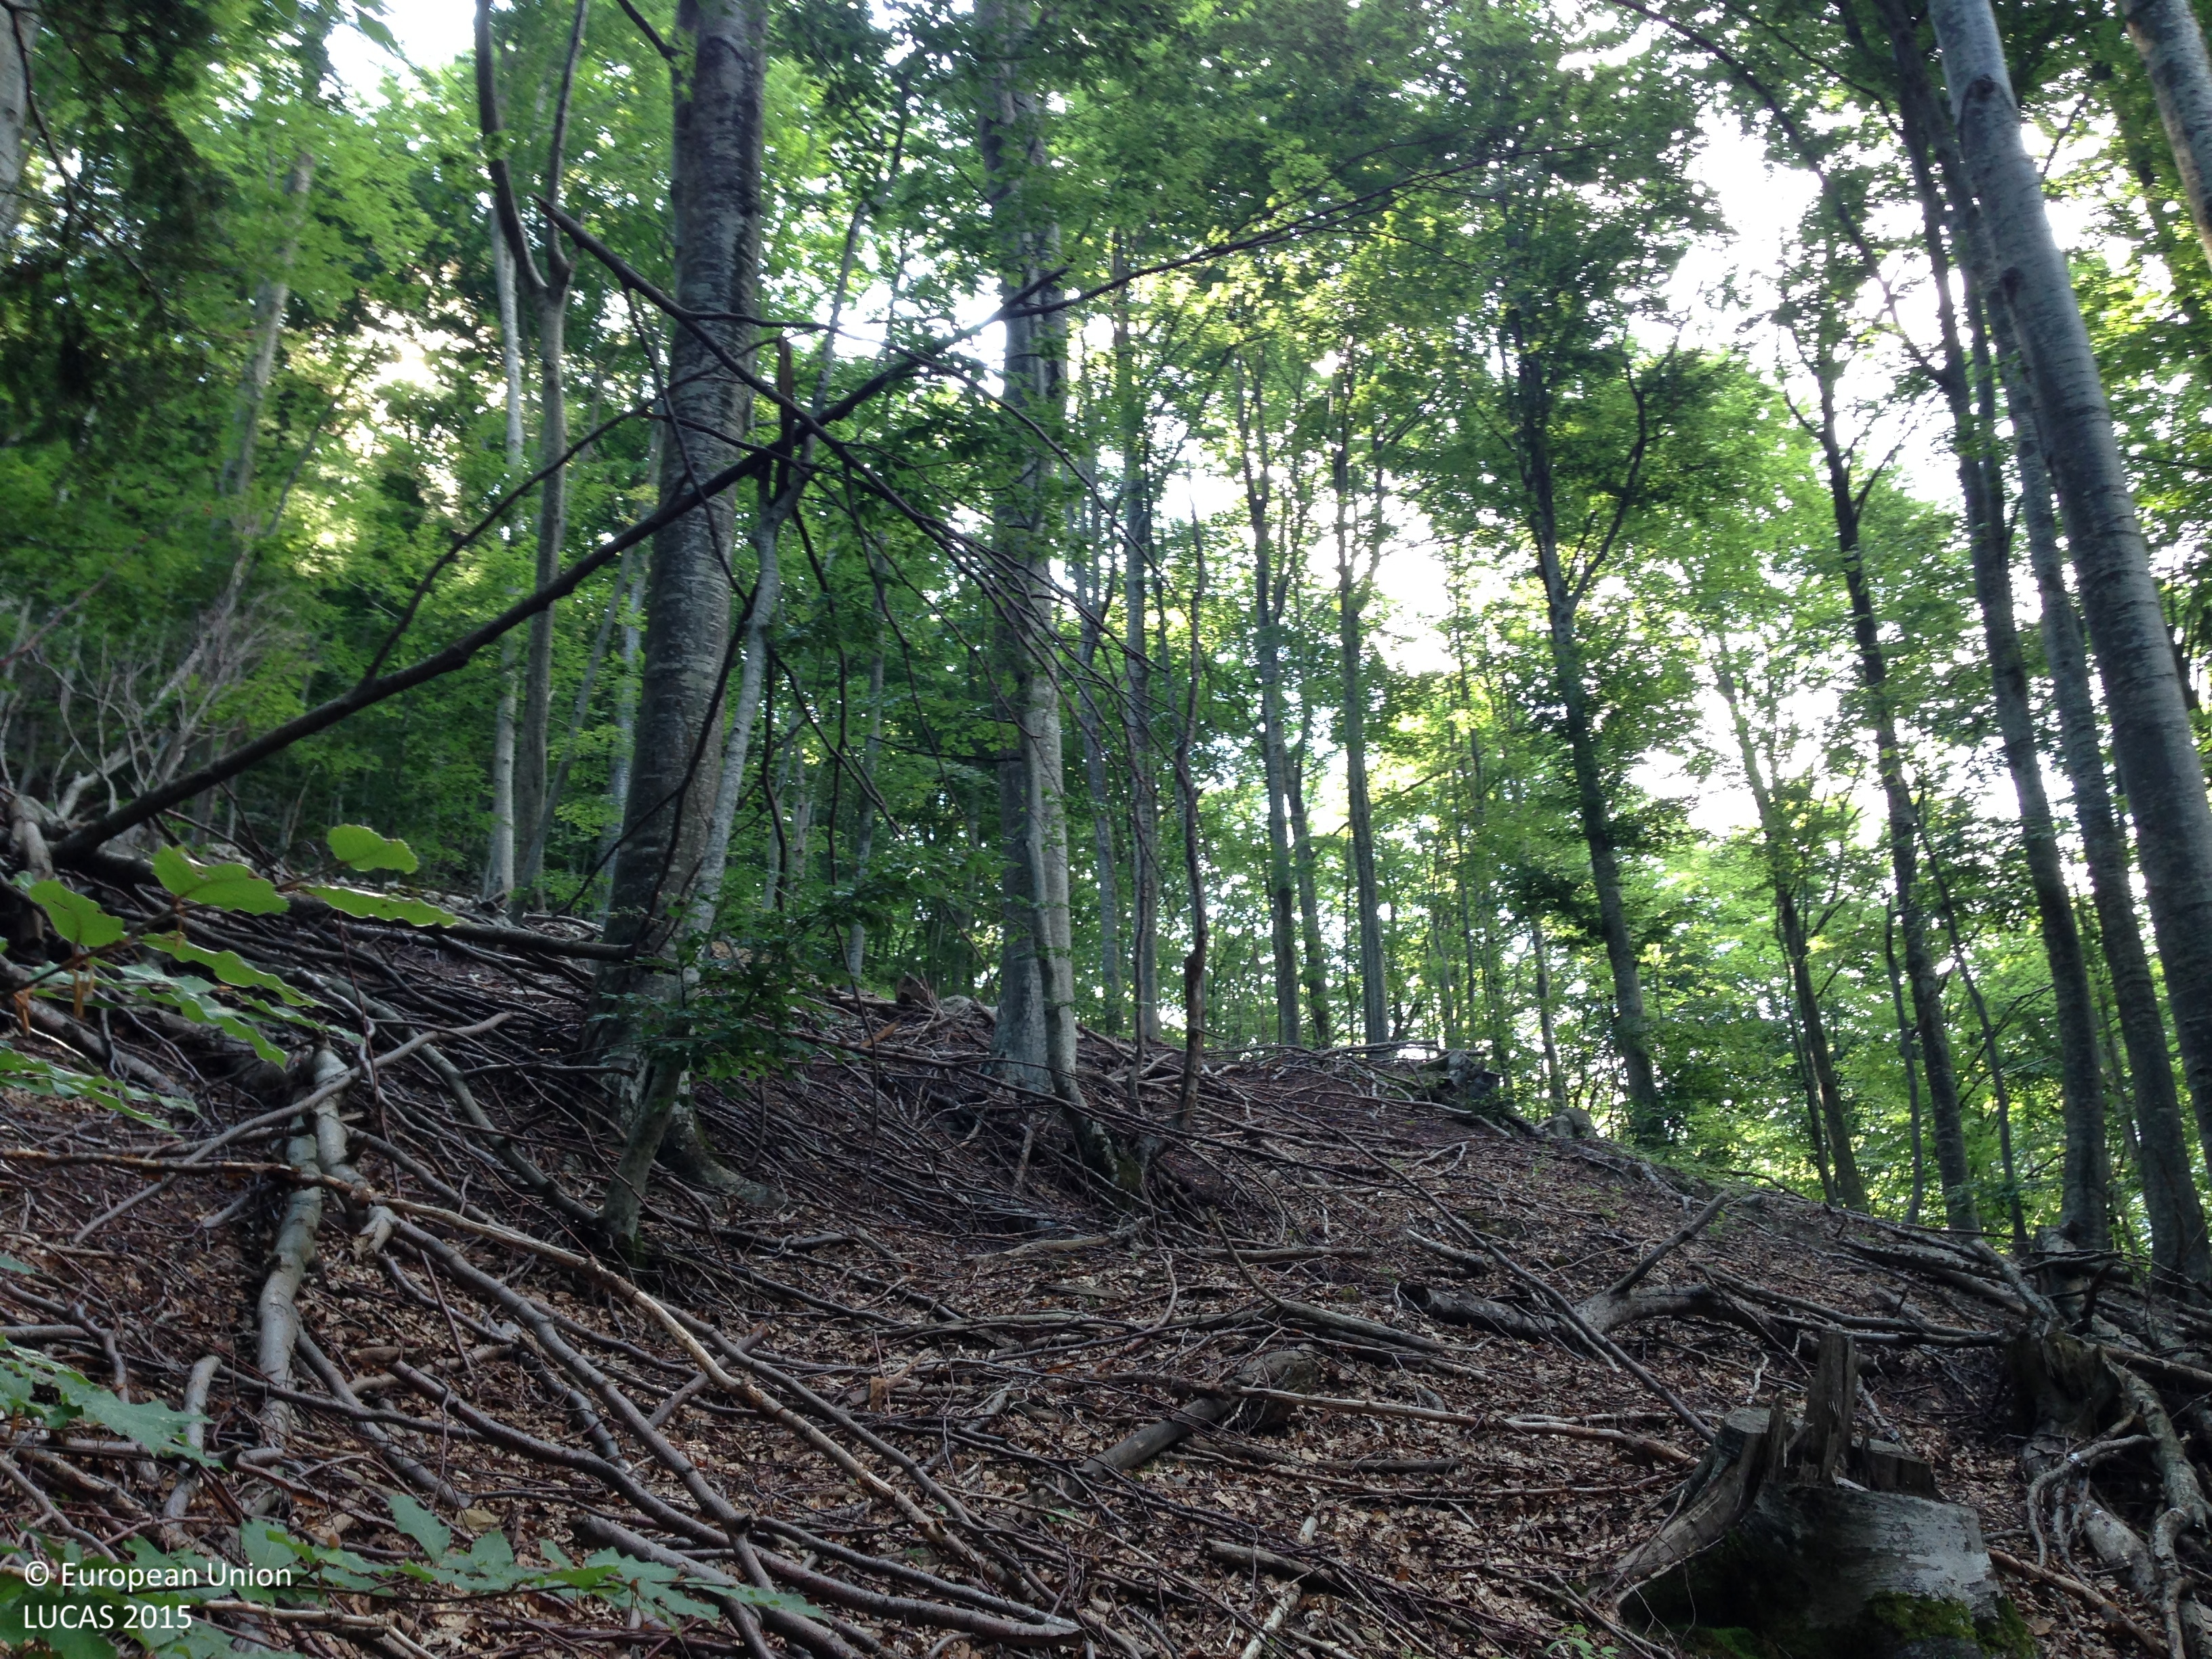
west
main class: Woodland
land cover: Other mixed woodland
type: mountainous beech forest
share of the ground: > 75 %
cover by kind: broadleaved forest trees 60 %, coniferous forest trees 20 %, lichens and mosses 10 %, shrubs 5 %, unconsolidated bare surface 5 %
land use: Forestry
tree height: > 5 m
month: July
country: HR
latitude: 44.6203
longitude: 15.1480
